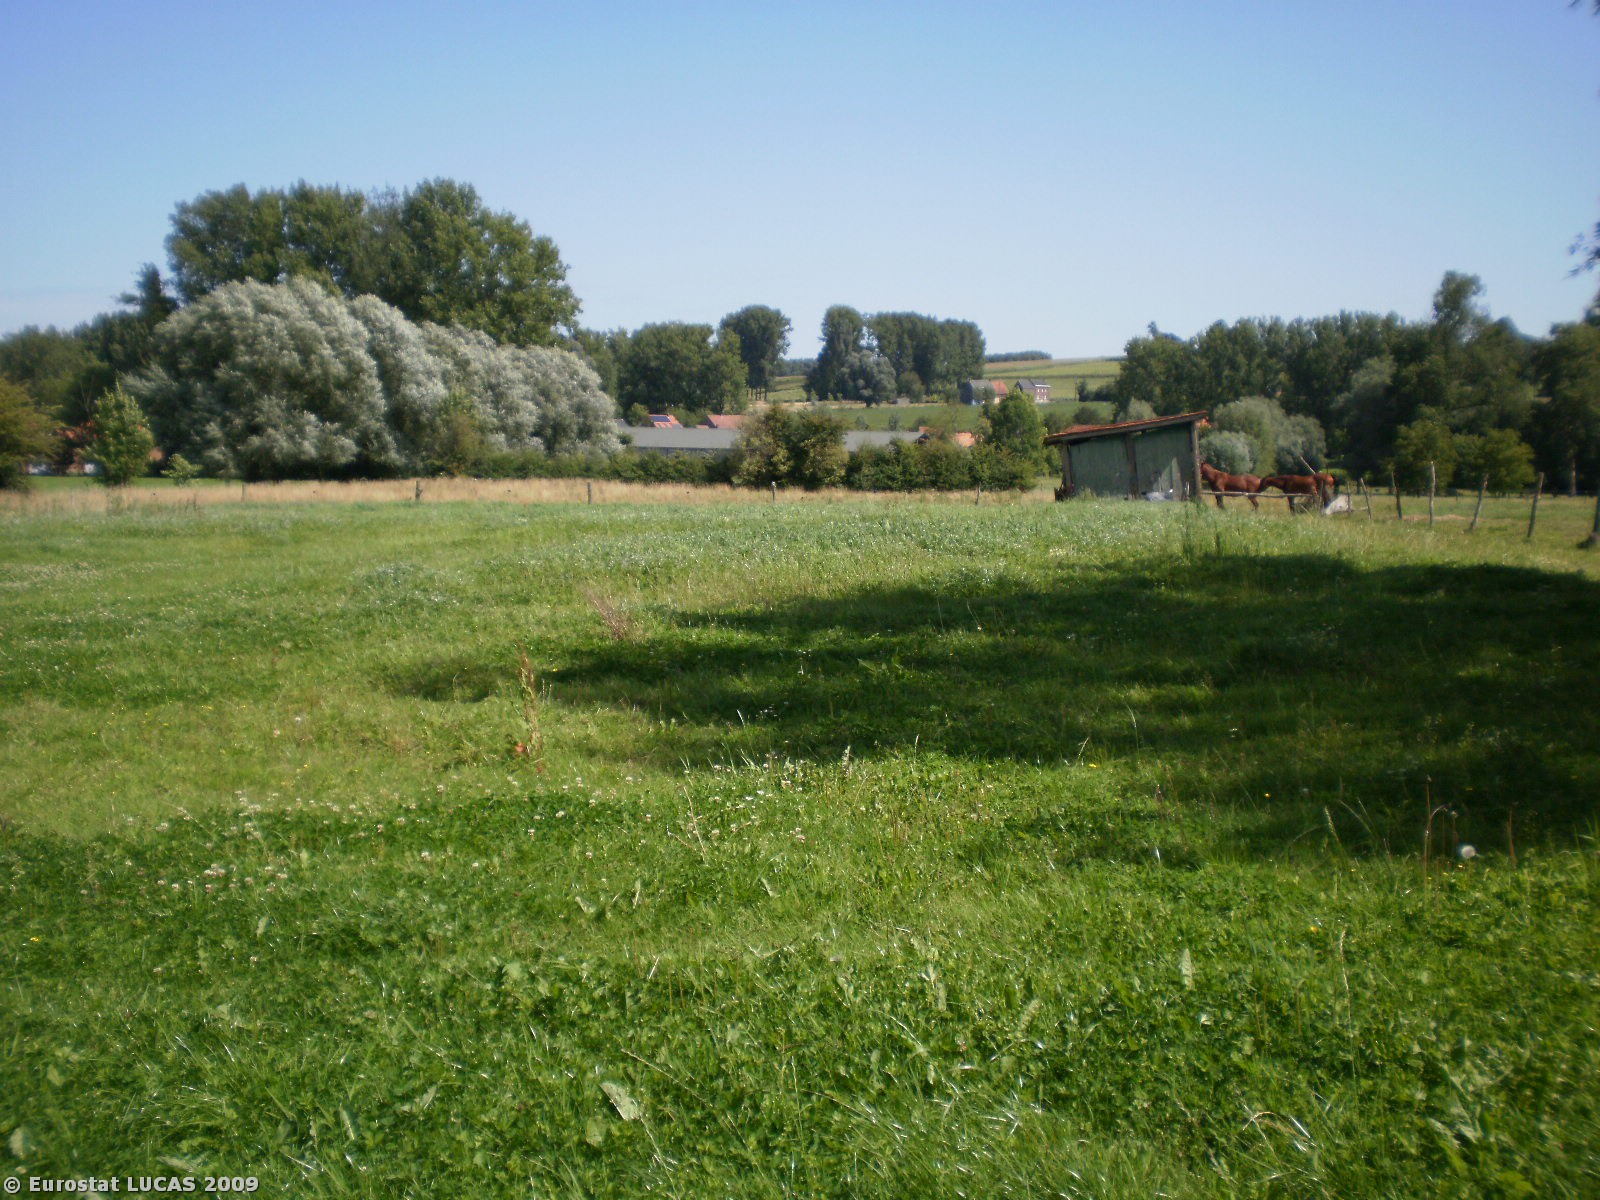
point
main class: Grassland
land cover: Grassland without tree/shrub cover
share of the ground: > 75 %
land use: Agriculture (excluding fallow land and kitchen gardens)
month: August
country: BE
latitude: 50.8429
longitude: 3.7587
